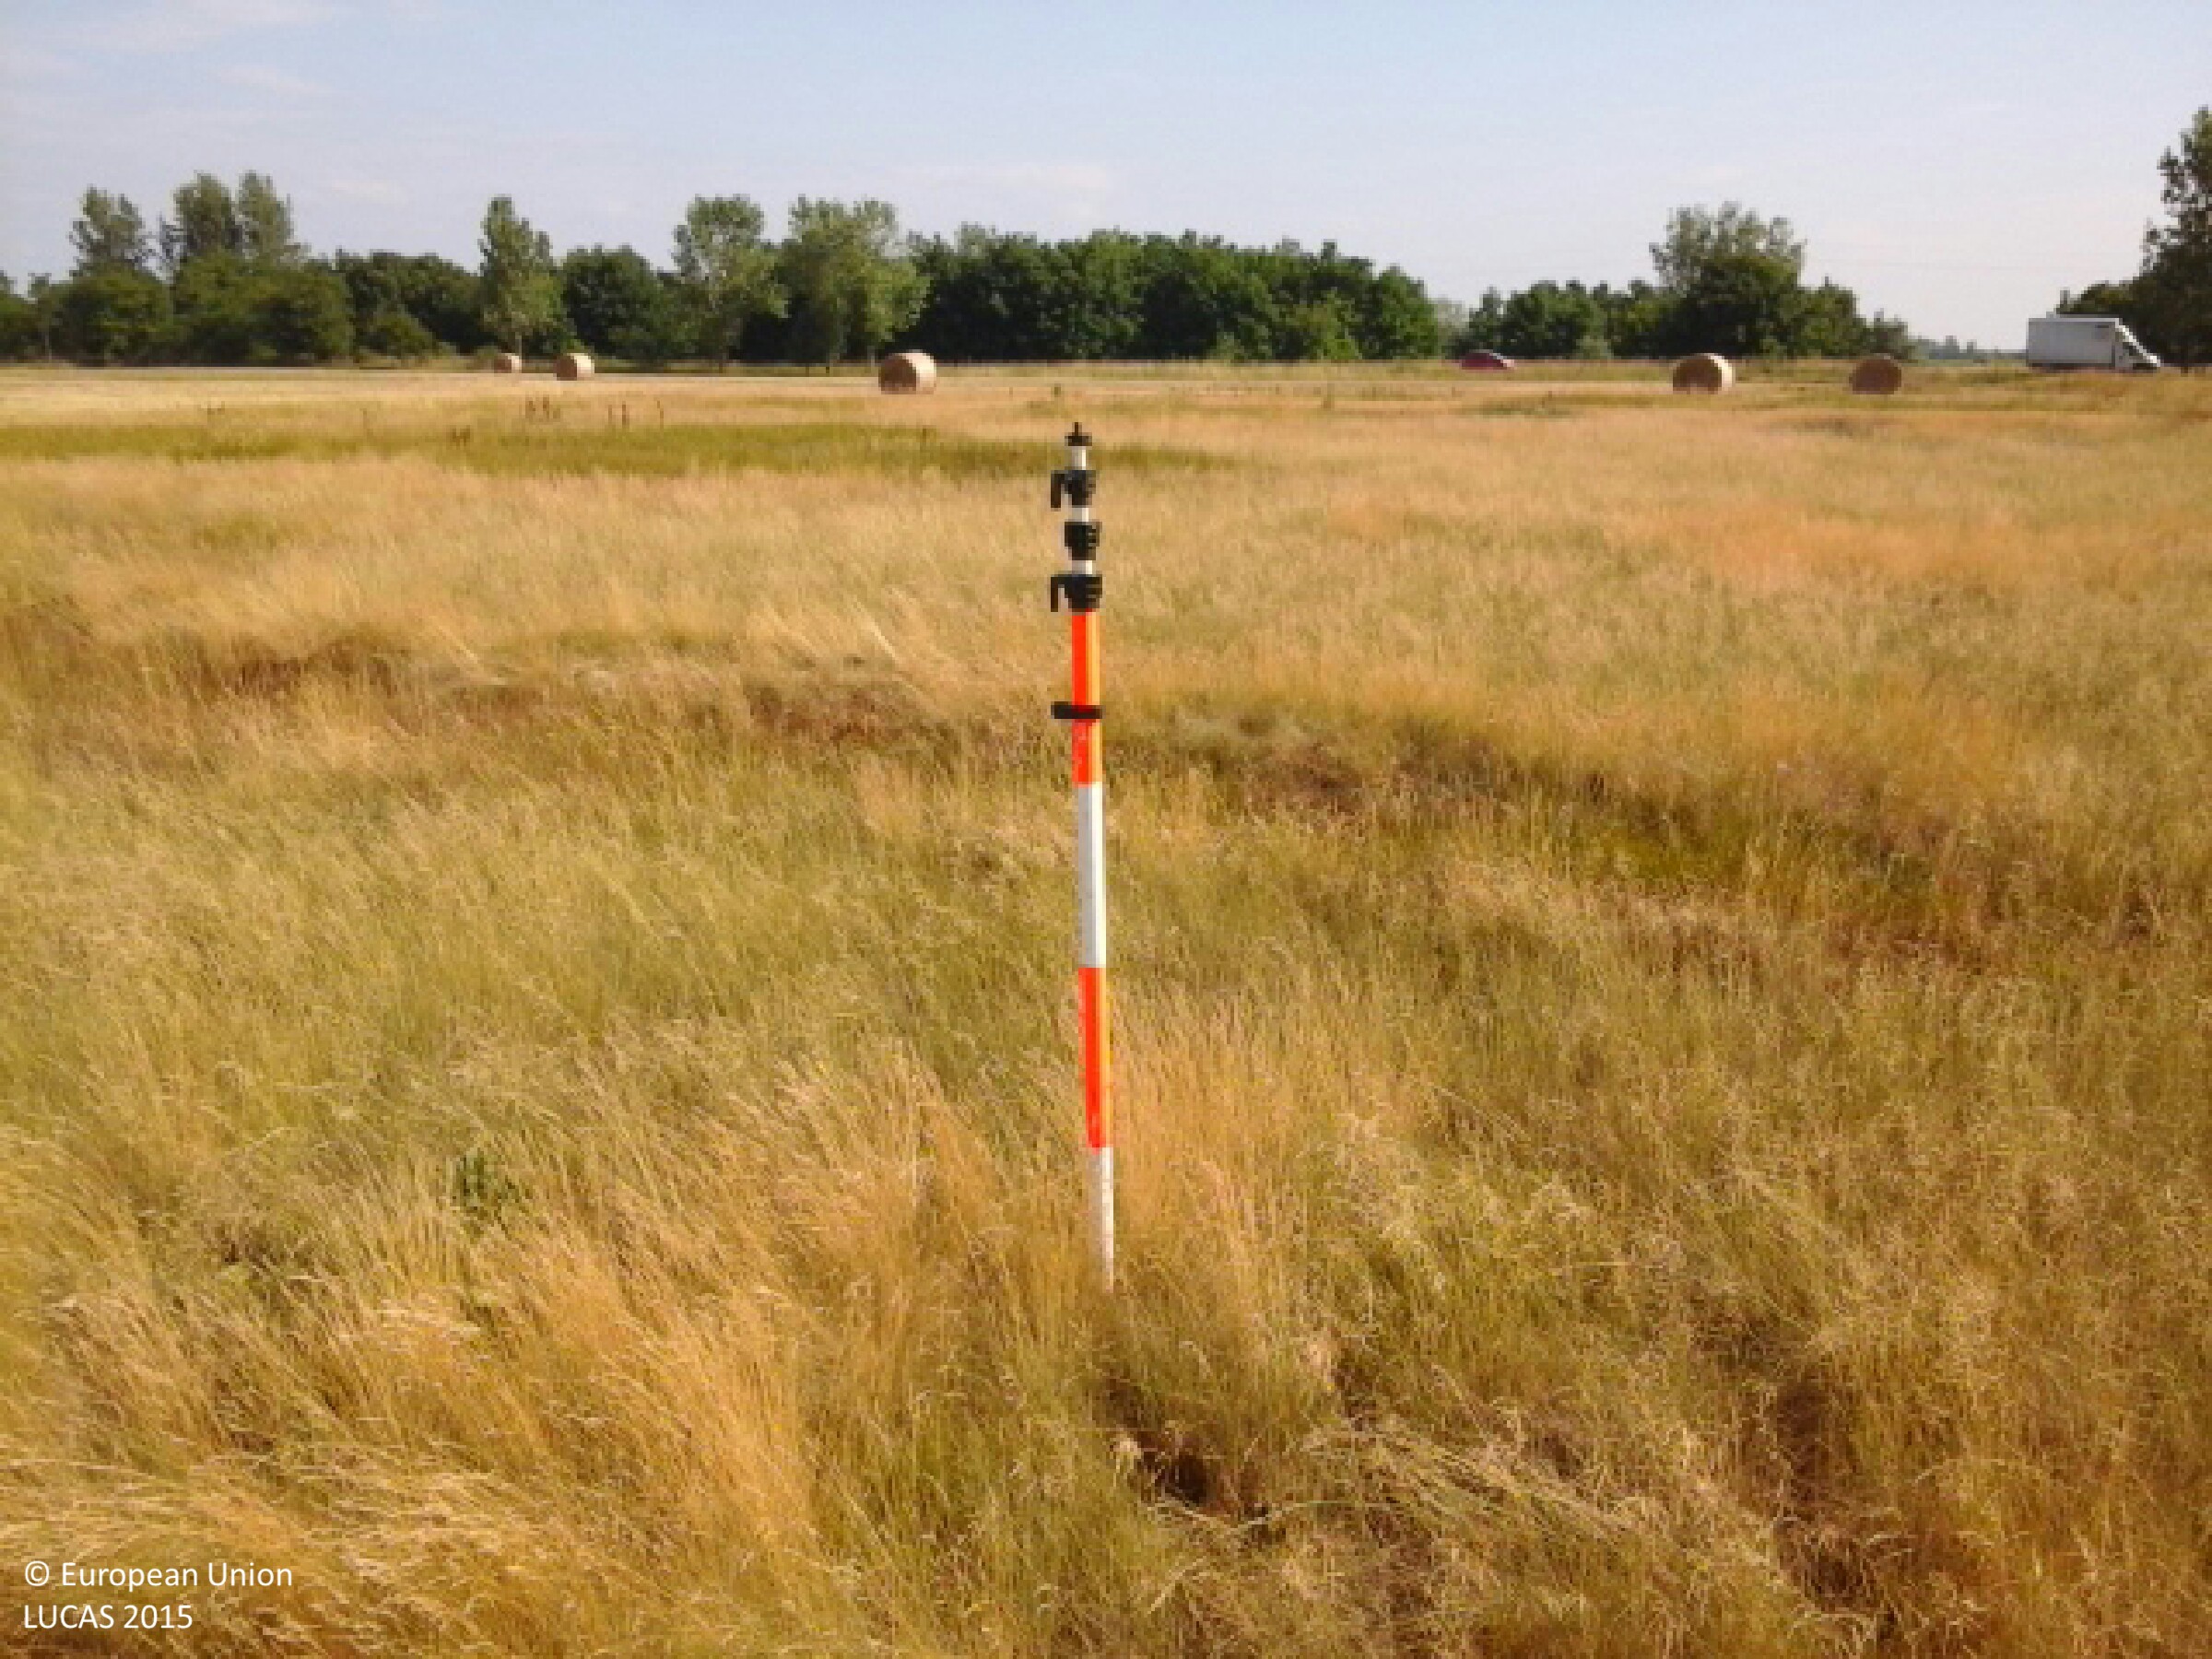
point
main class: Grassland
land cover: Grassland without tree/shrub cover
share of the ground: > 75 %
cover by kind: herbaceous plants 100 %
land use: Semi-natural and natural areas not in use
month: June
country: HU
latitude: 48.0007
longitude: 21.5045
